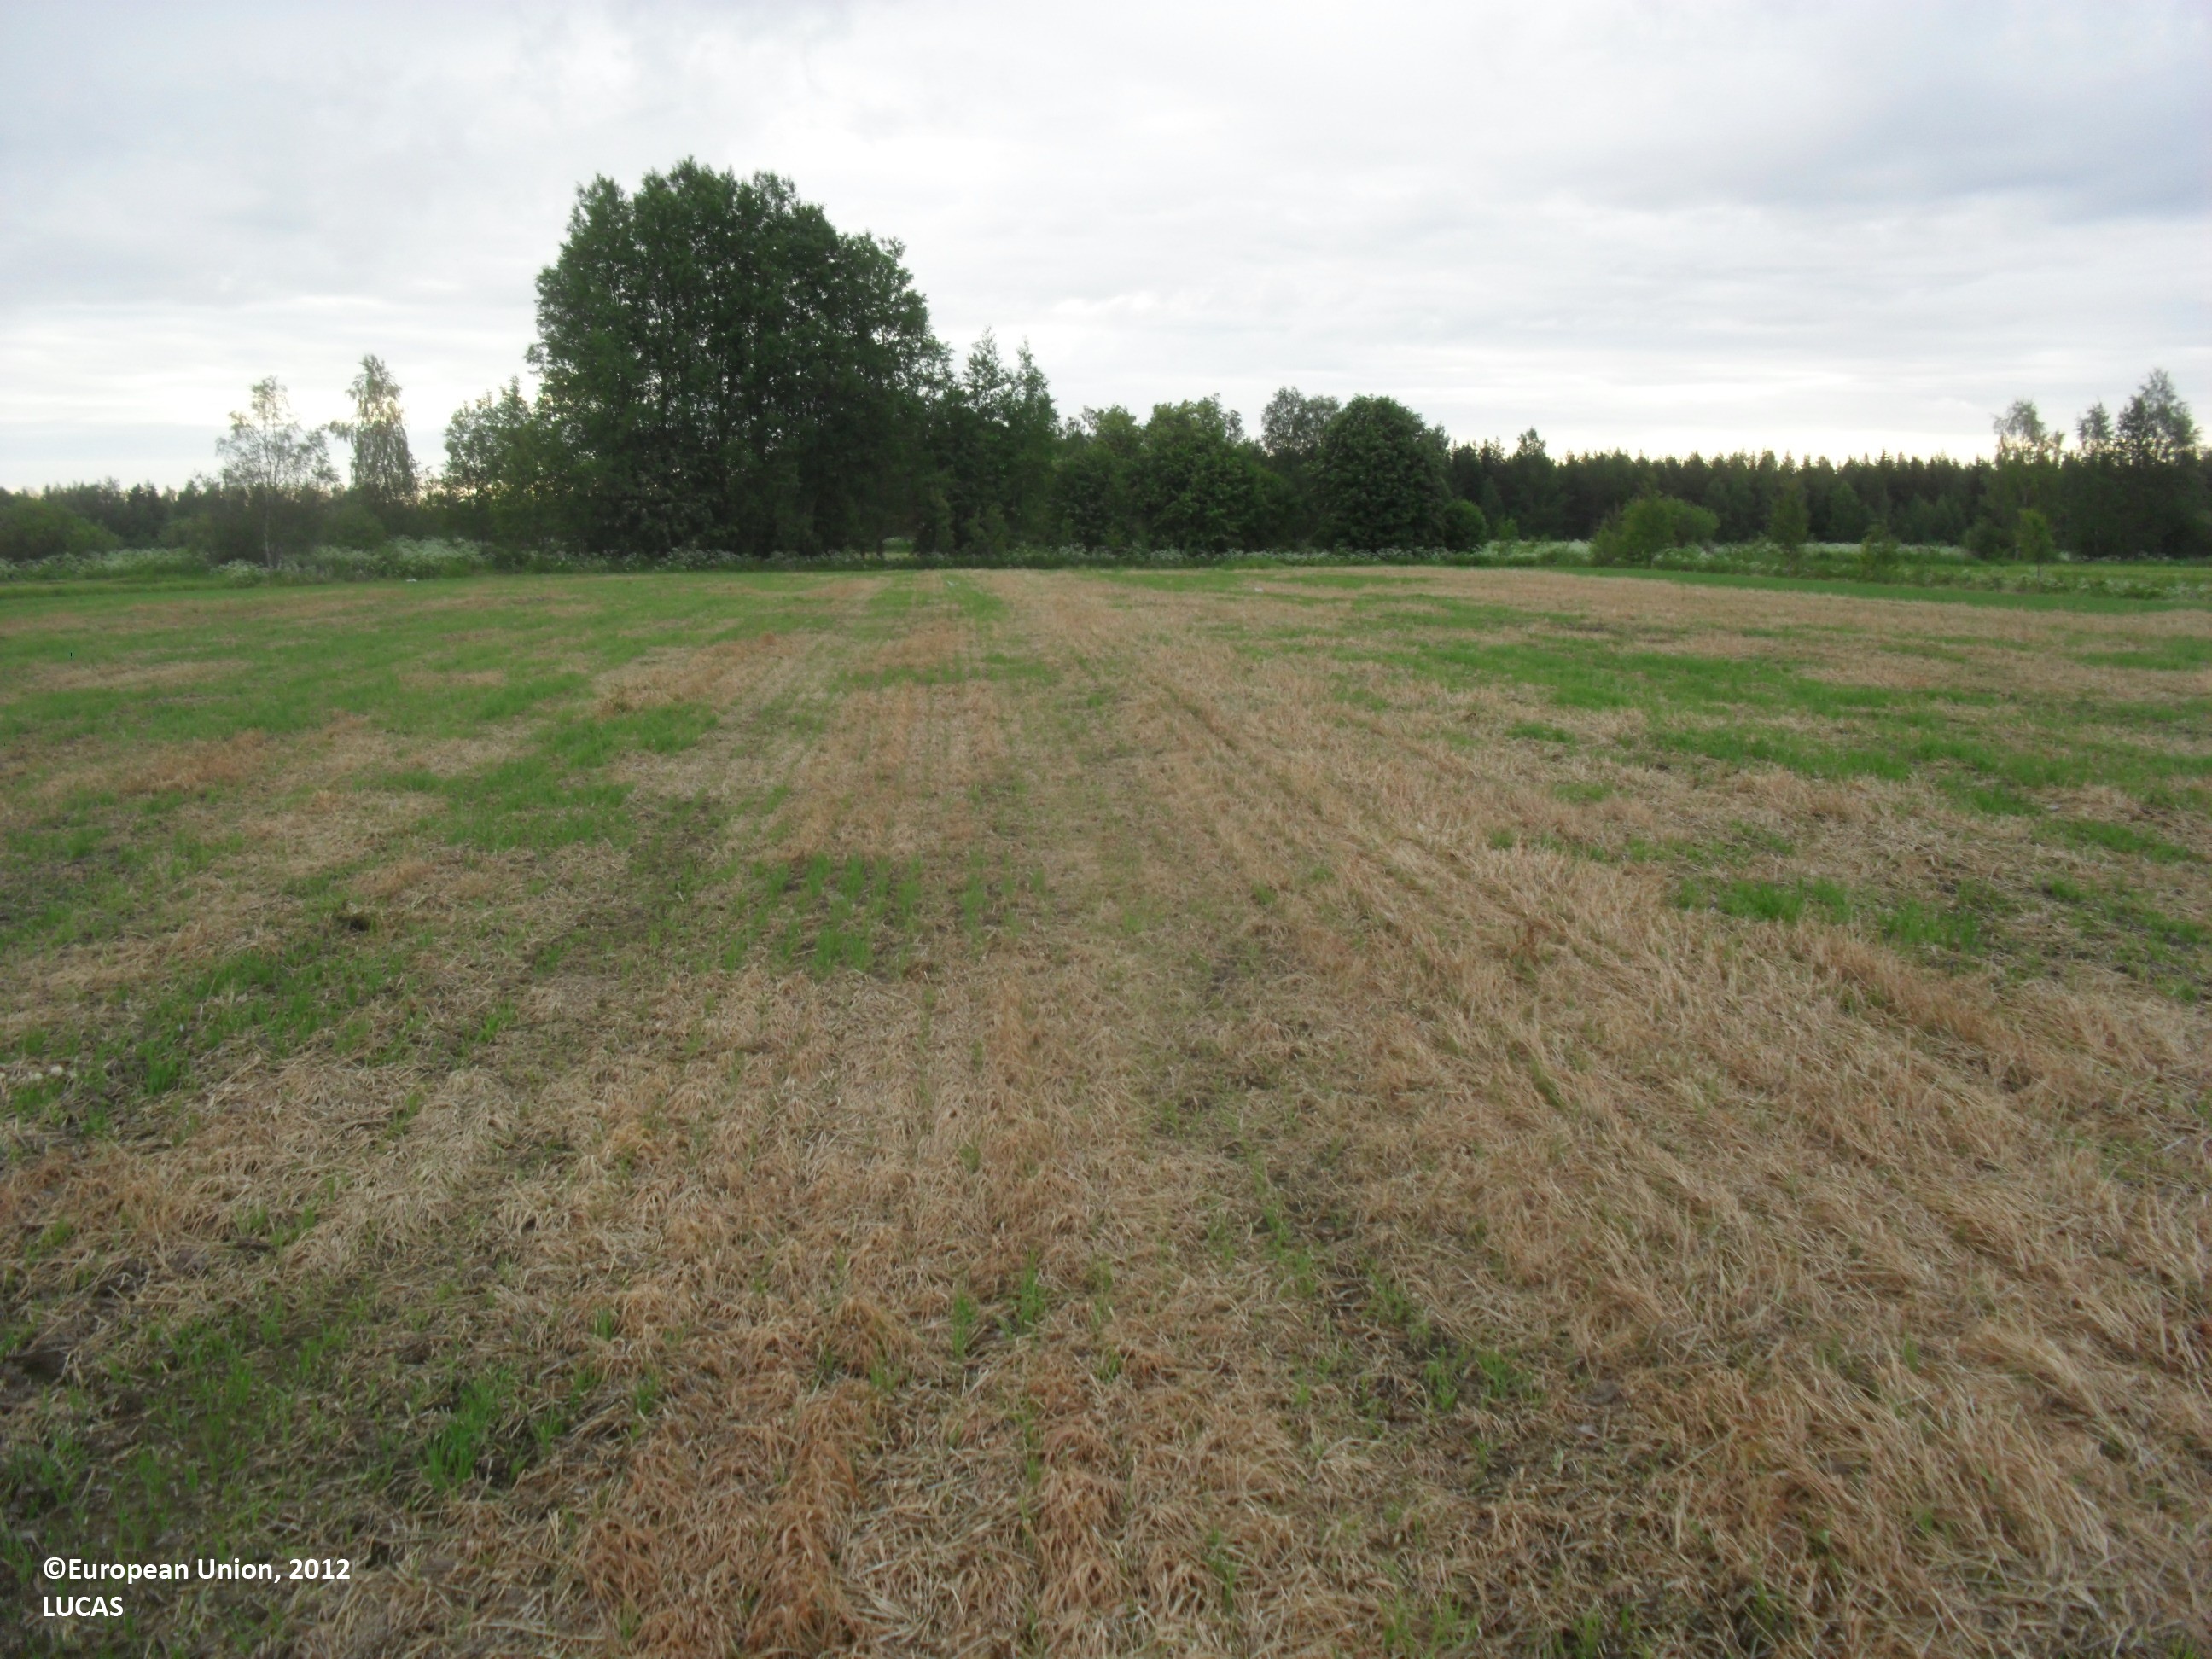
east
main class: Cropland
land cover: Barley
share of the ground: < 10 %
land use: Agriculture (excluding fallow land and kitchen gardens)
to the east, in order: Barley; Ditches and canals; Temporary grasslands; Spontaneously vegetated surfaces; Ditches and canals; Tracks; Spontaneously vegetated surfaces; Ditches and canals; Temporary grasslands; Ditches and canals
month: June
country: FI
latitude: 63.3216
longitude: 23.2962
